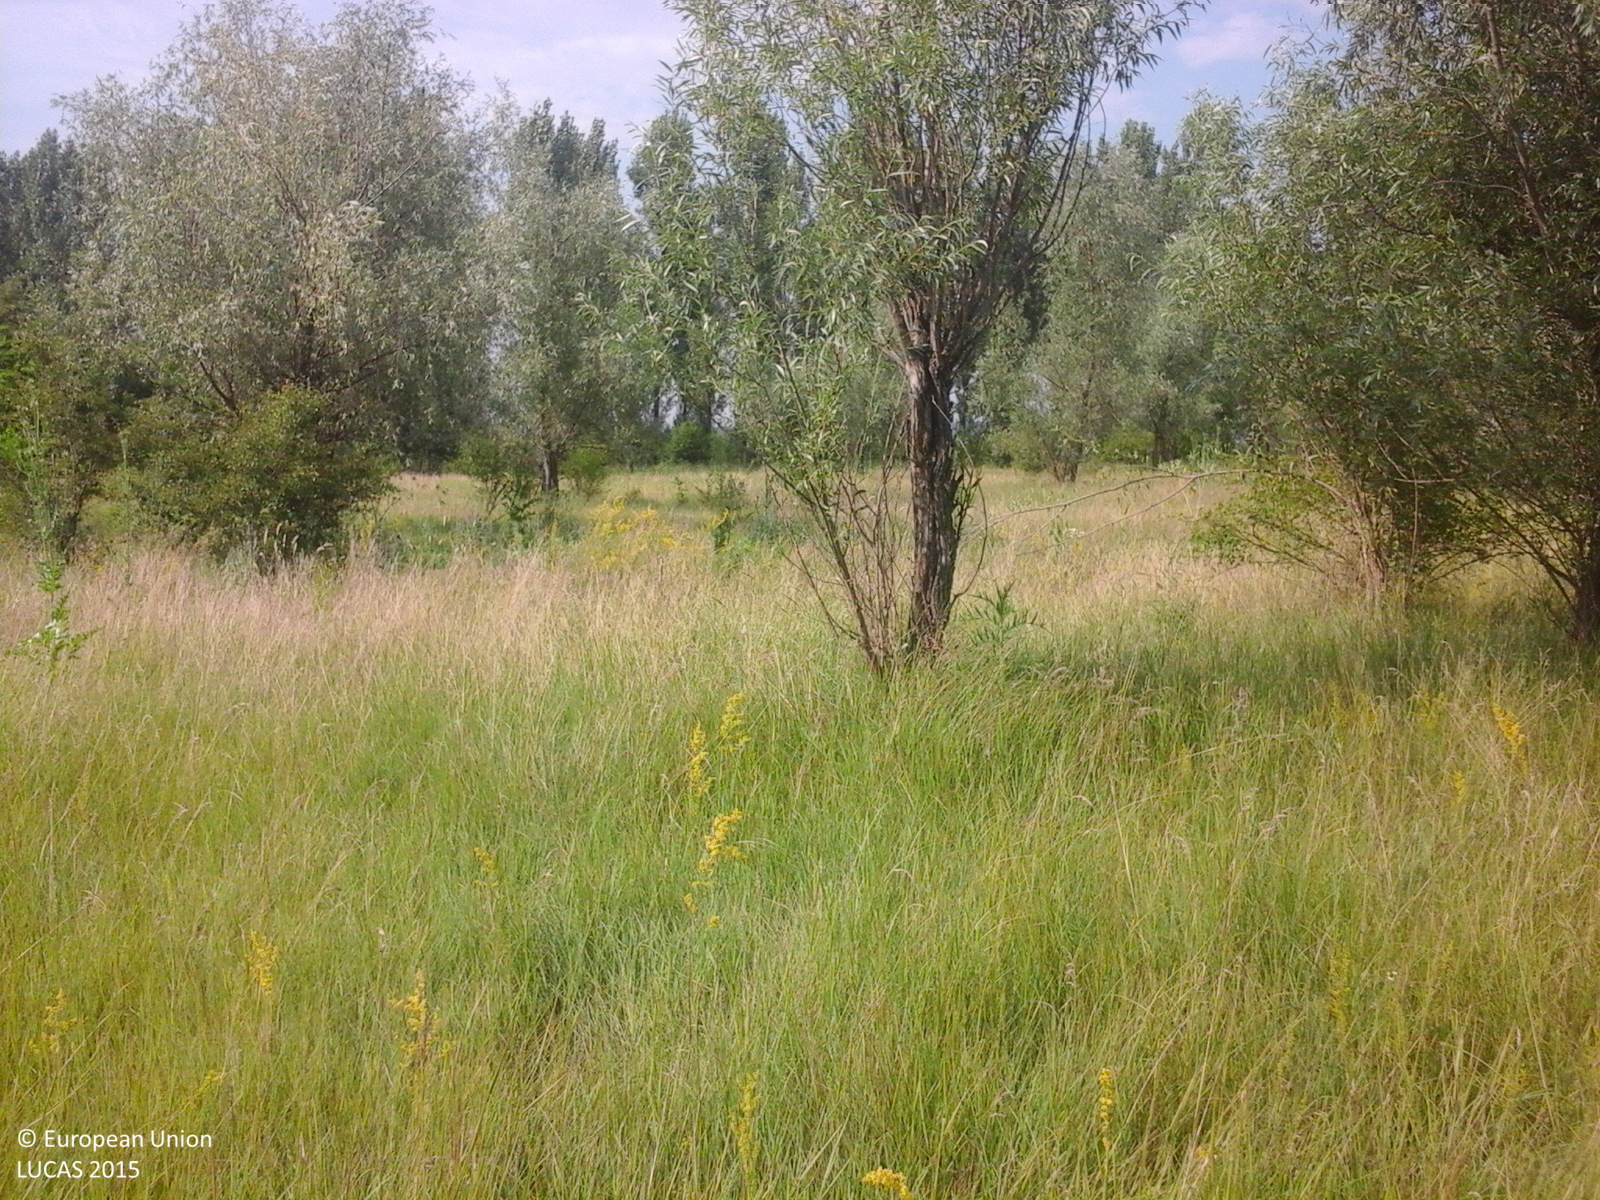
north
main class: Grassland
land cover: Grassland with sparse tree/shrub cover
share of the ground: > 75 %
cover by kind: herbaceous plants 85 %, shrubs 10 %, broadleaved forest trees 5 %
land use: Agriculture (excluding fallow land and kitchen gardens)
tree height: > 5 m
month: July
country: RO
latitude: 43.8237
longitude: 24.7290
